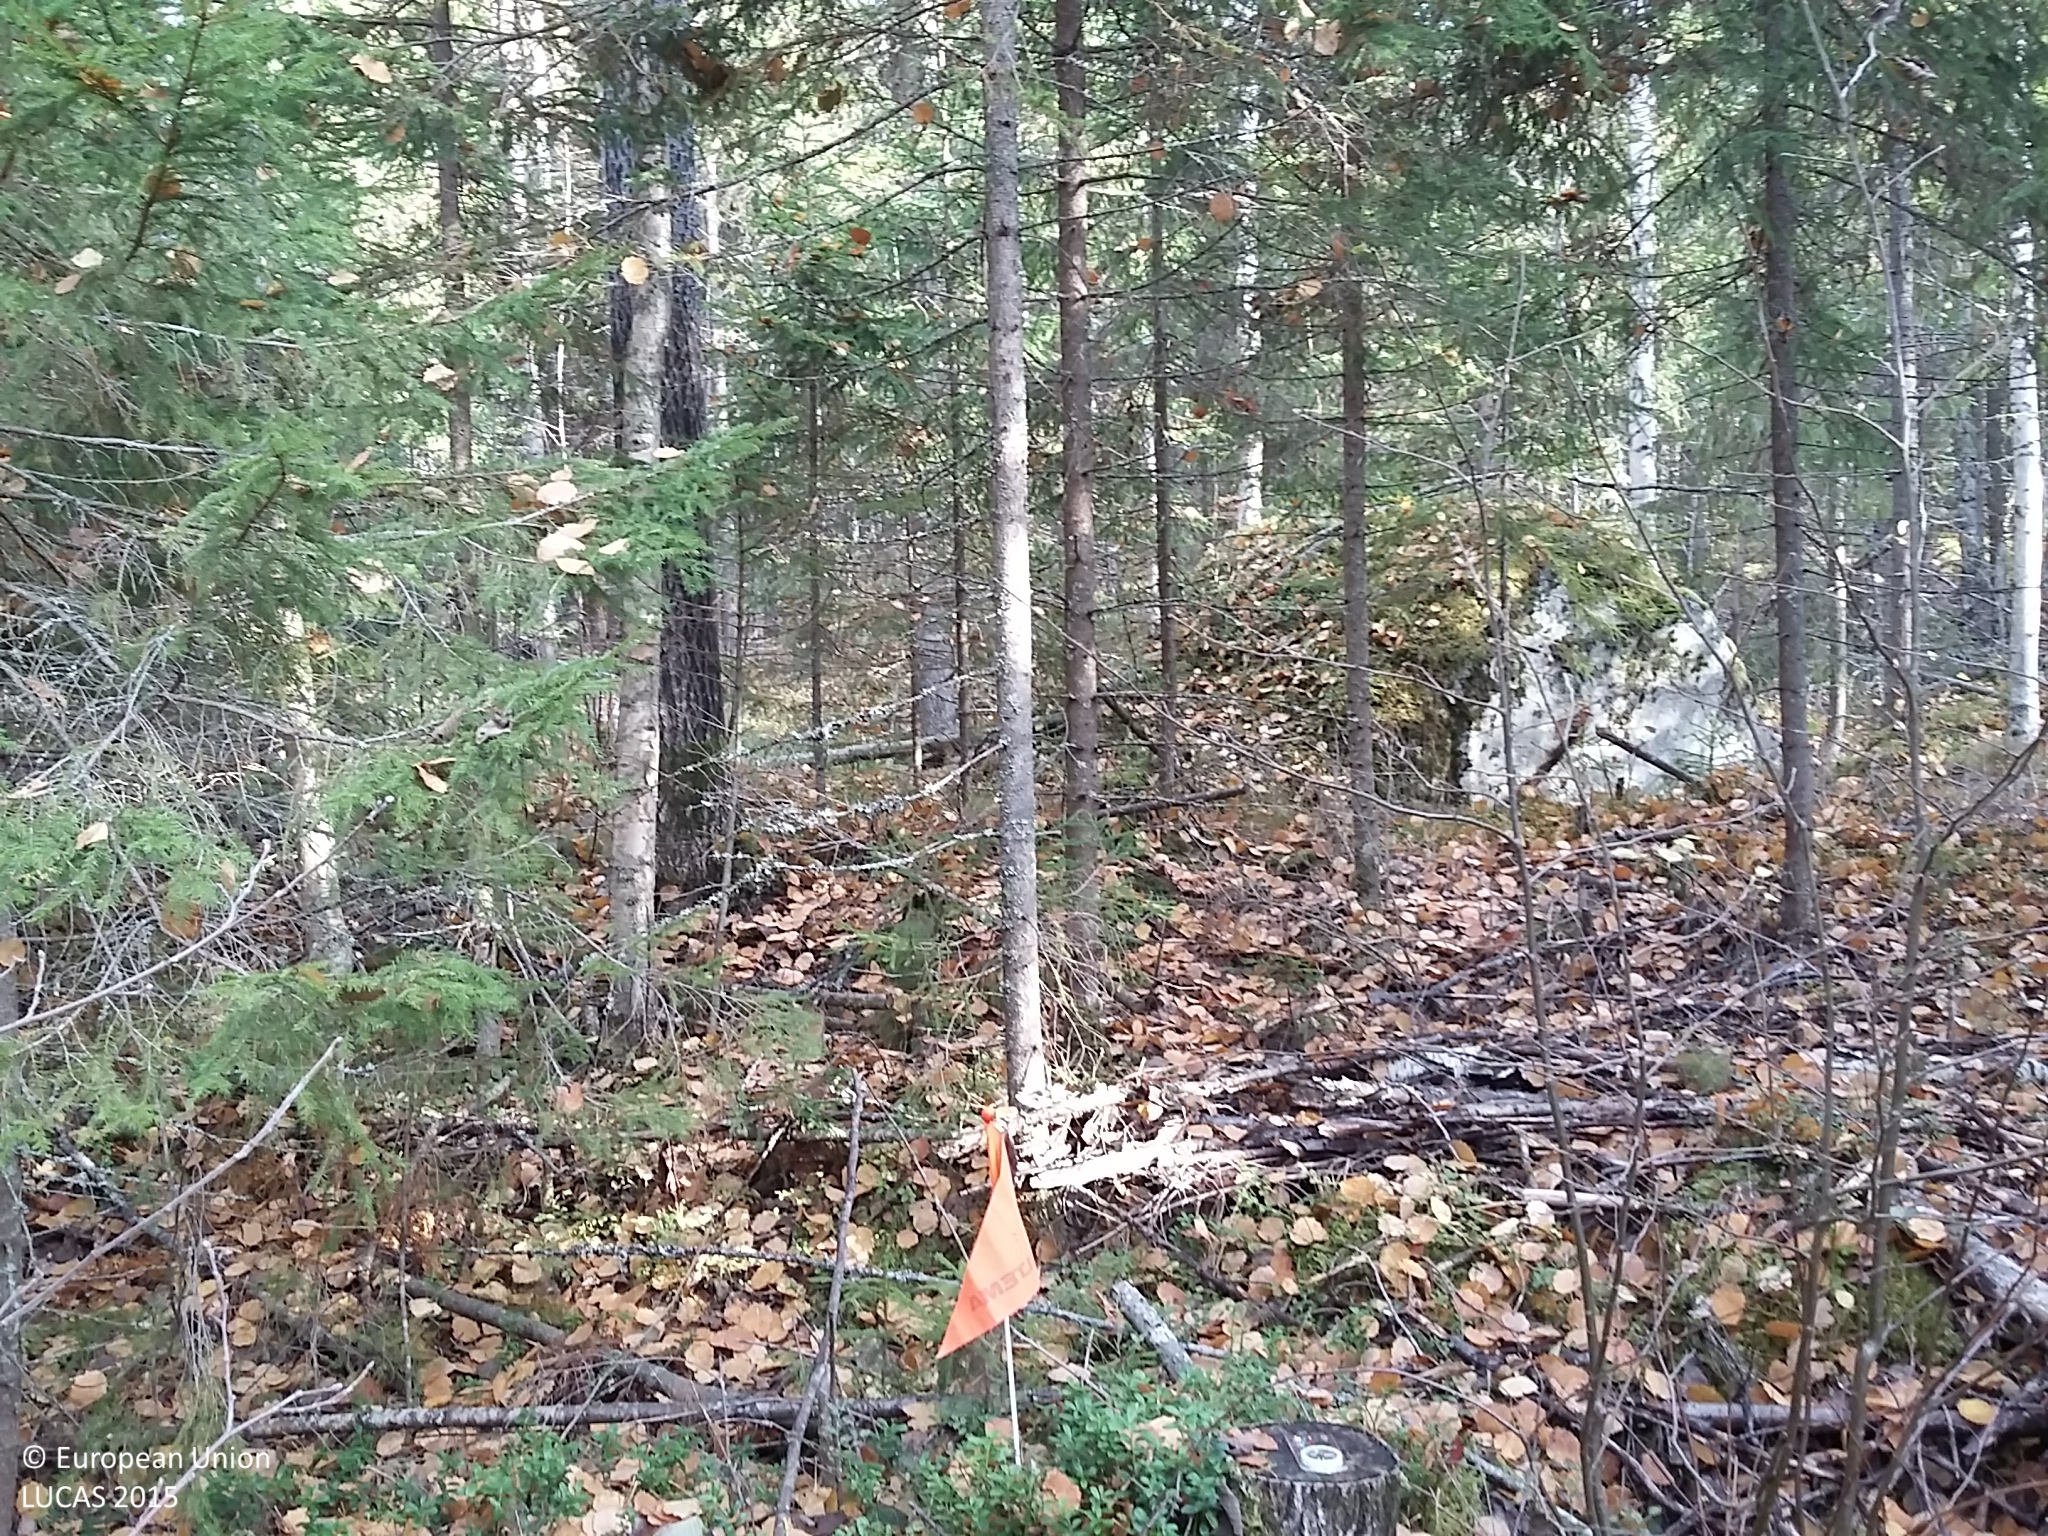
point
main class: Woodland
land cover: Spruce dominated mixed woodland
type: boreal forest
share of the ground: > 75 %
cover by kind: coniferous forest trees 45 %, broadleaved forest trees 40 %, herbaceous plants 10 %, lichens and mosses 5 %
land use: Forestry
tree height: > 5 m
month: October
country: FI
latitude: 62.7987
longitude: 26.0245
